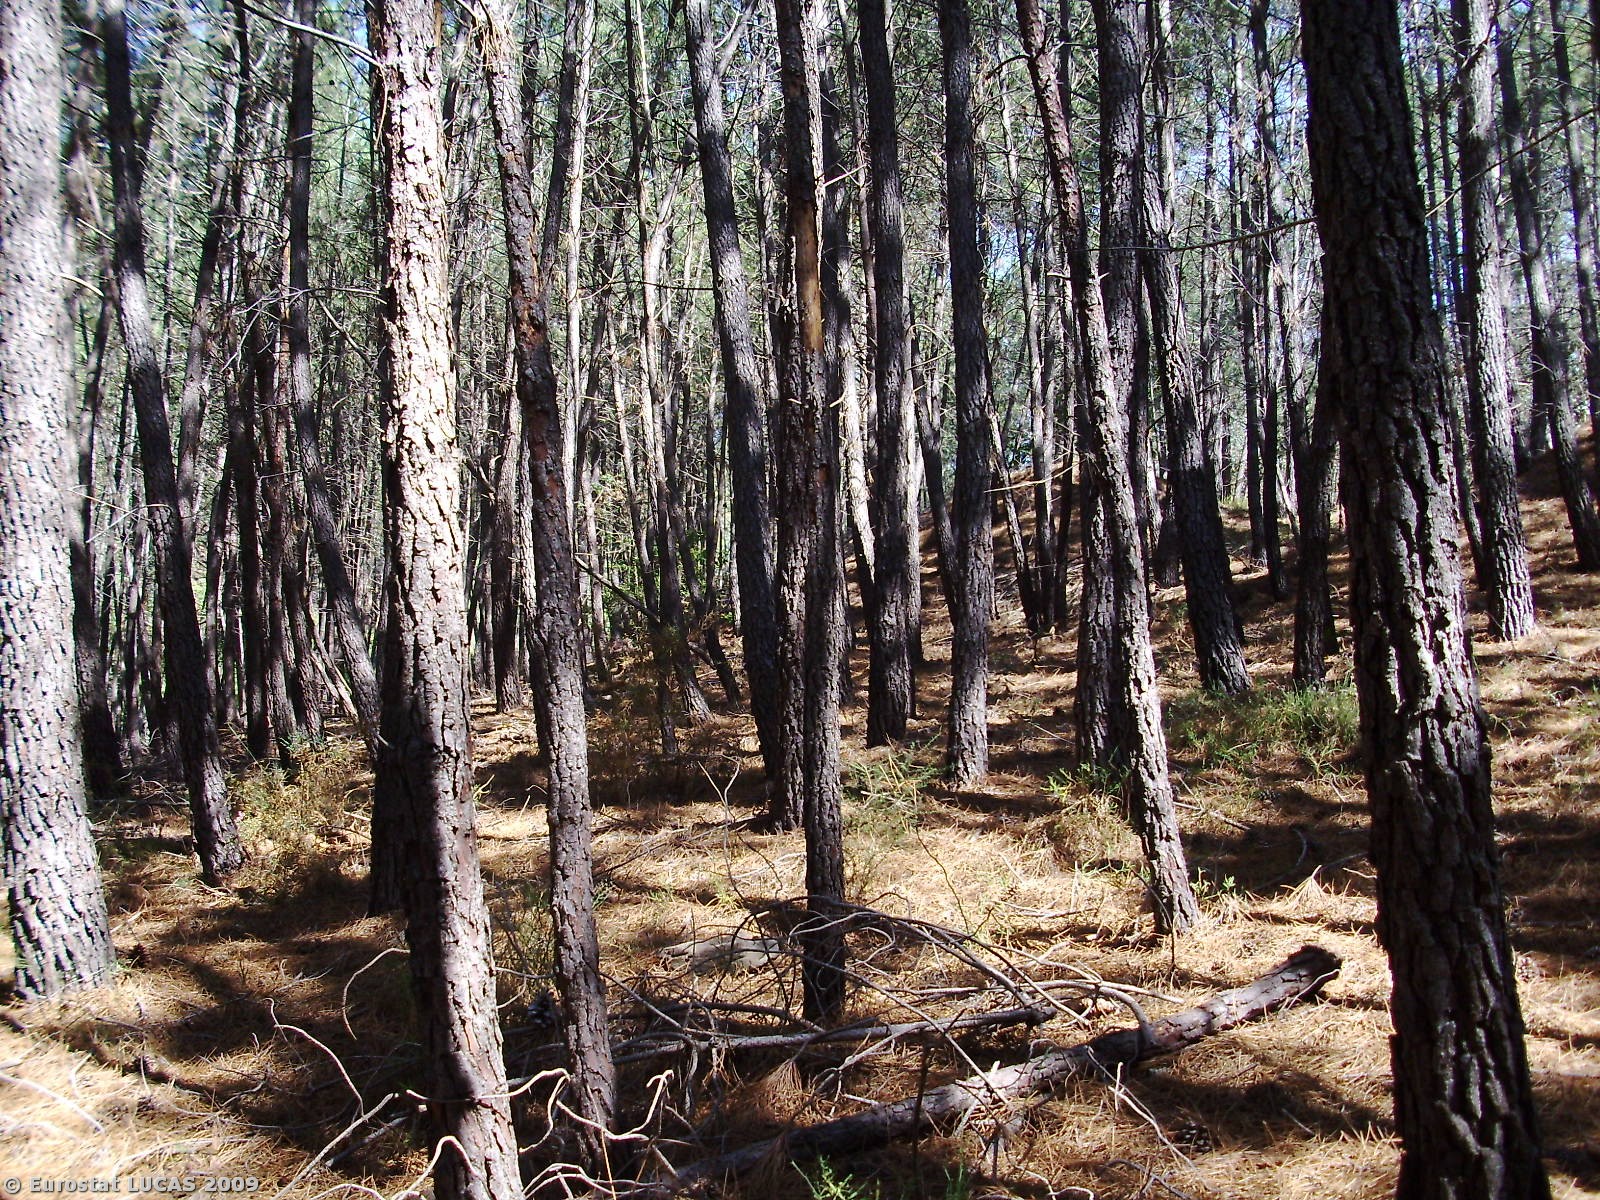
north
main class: Woodland
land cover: Coniferous woodland
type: coniferous forest of the mediterranean region
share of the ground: > 75 %
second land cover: Shrubland with sparse tree cover
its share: 10 - 25 %
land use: Forestry
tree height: > 5 m
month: August
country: PT
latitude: 39.9967
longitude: -8.1688
